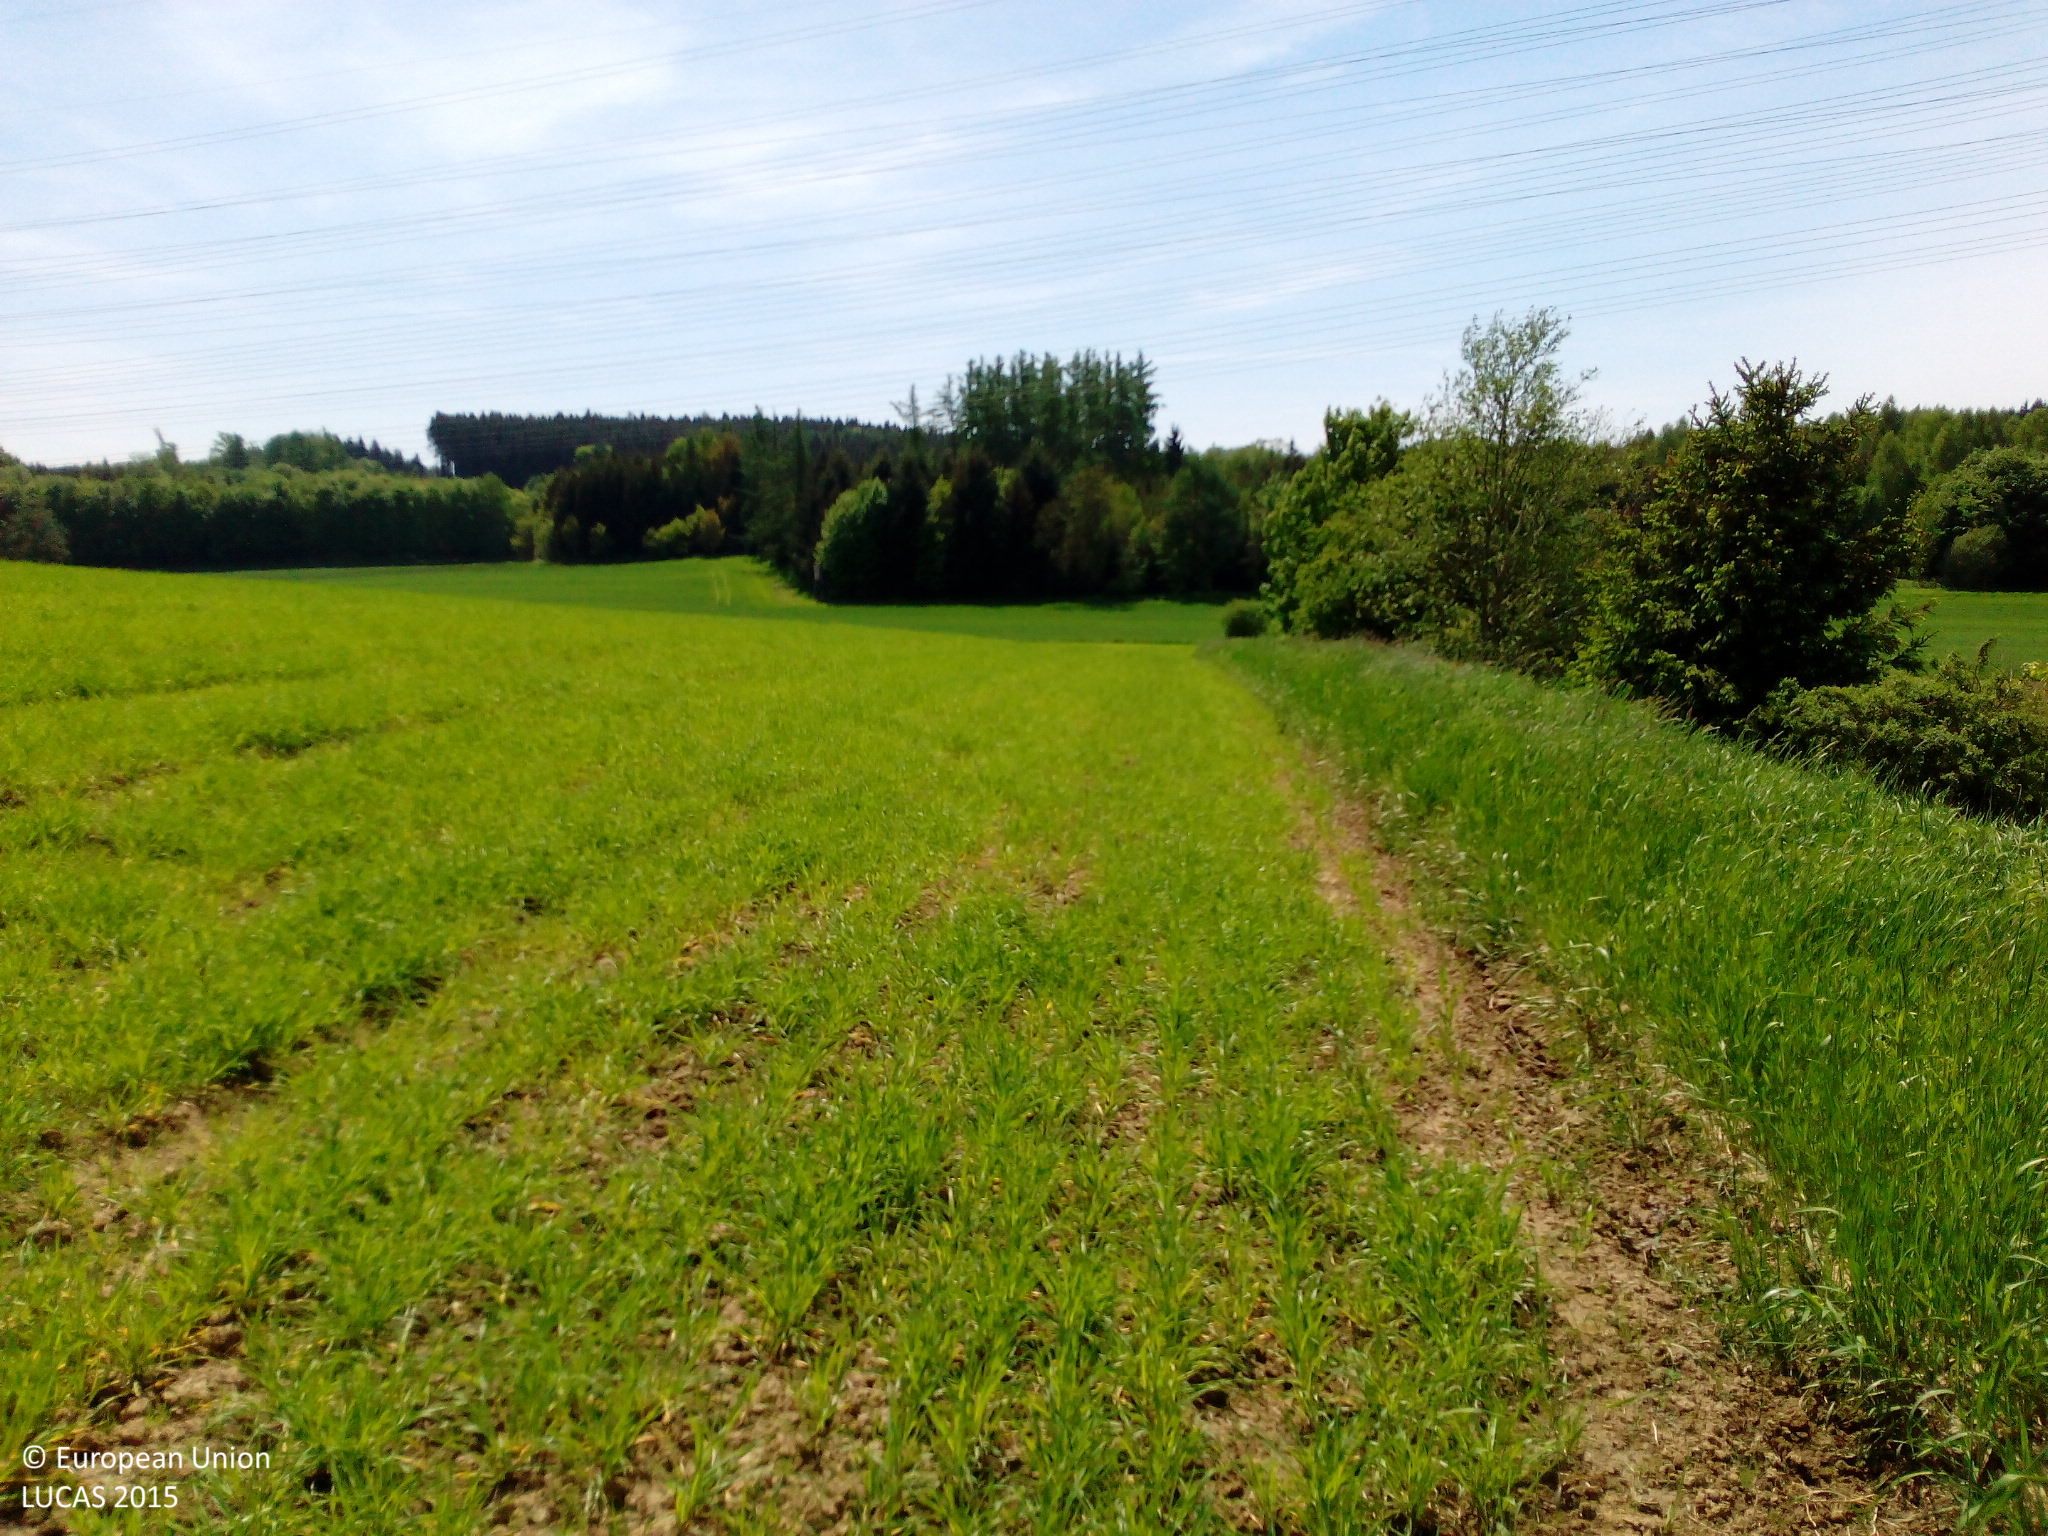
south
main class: Cropland
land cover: Barley
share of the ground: > 75 %
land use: Agriculture (excluding fallow land and kitchen gardens)
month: May
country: DE
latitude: 48.3217
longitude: 11.4693
